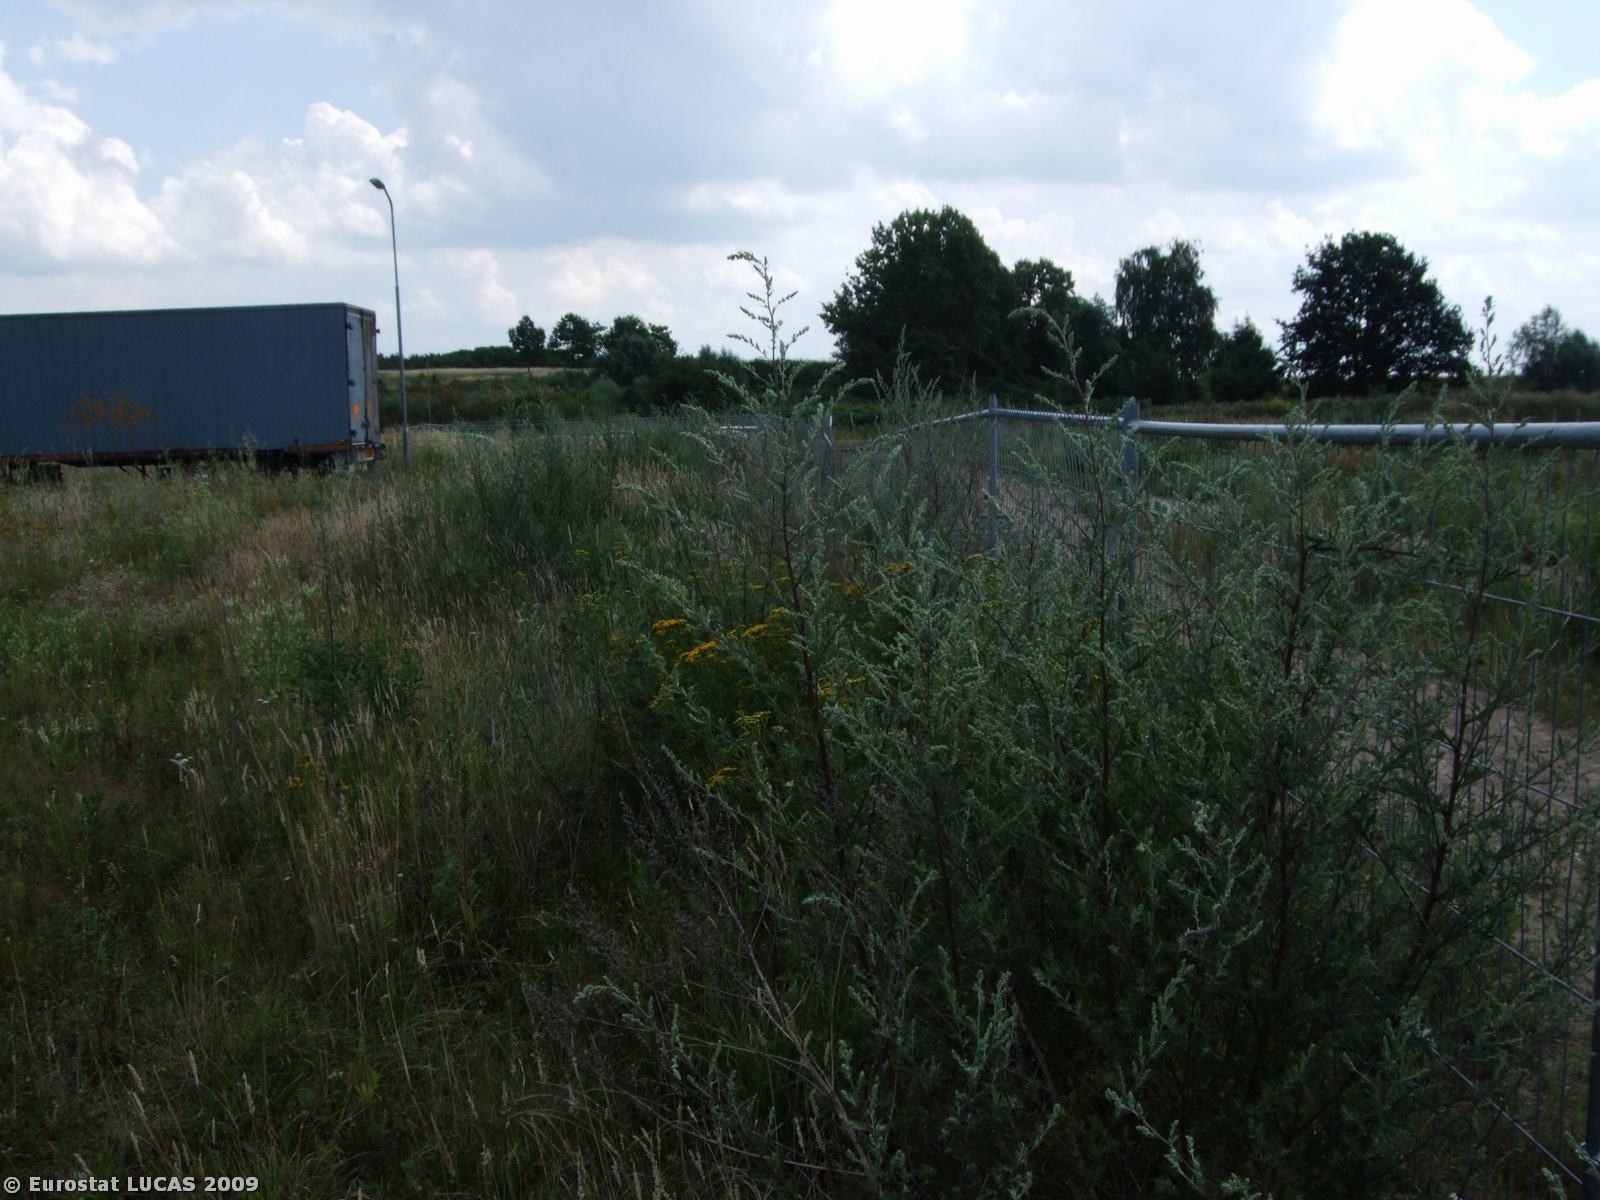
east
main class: Grassland
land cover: Spontaneously vegetated surfaces
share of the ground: 50 - 75 %
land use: Unused
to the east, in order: Spontaneously vegetated surfaces; Fences; Spontaneously vegetated surfaces; Tracks; Spontaneously vegetated surfaces; Broadleaved woodland; Grassland without tree/shrub cover
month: July
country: NL
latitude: 51.8942
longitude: 5.4498
